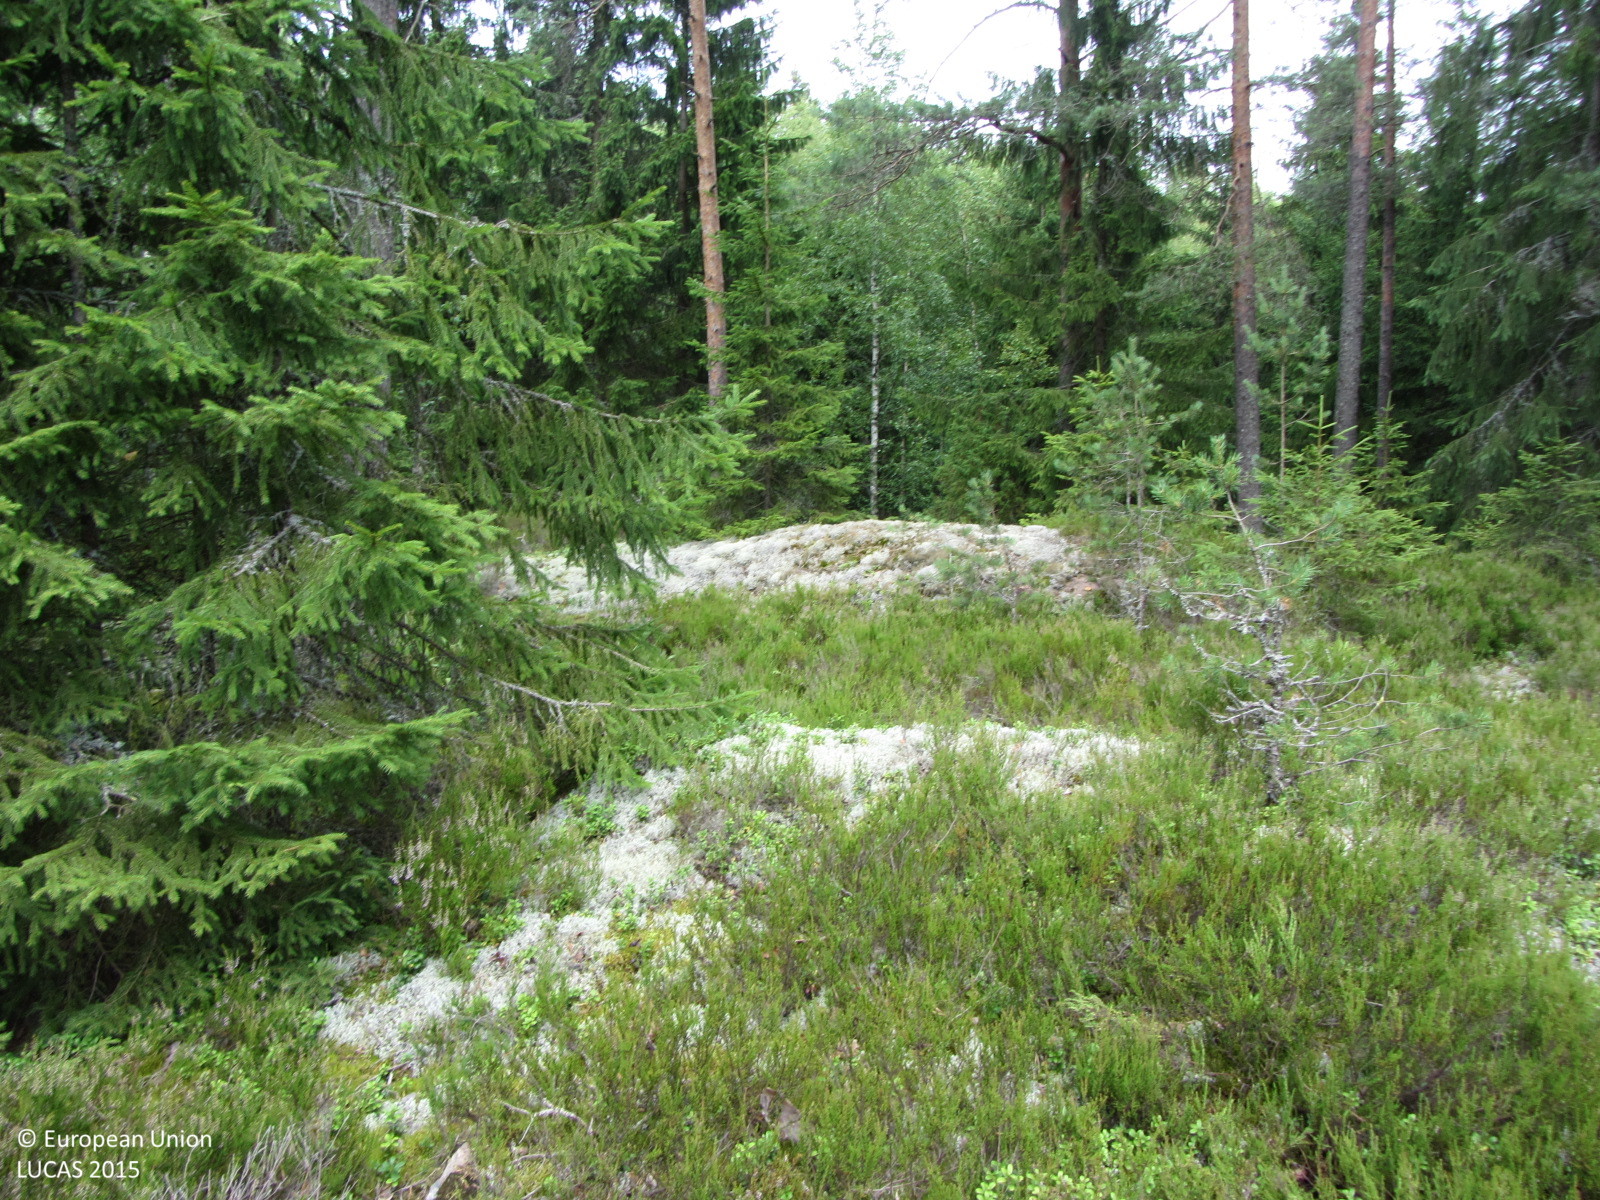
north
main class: Woodland
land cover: Other coniferous woodland
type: boreal forest
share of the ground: 50 - 75 %
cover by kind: coniferous forest trees 45 %, shrubs 25 %, lichens and mosses 20 %, broadleaved forest trees 5 %, herbaceous plants 5 %
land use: Forestry
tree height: > 5 m
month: July
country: FI
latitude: 60.4760
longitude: 24.4592
